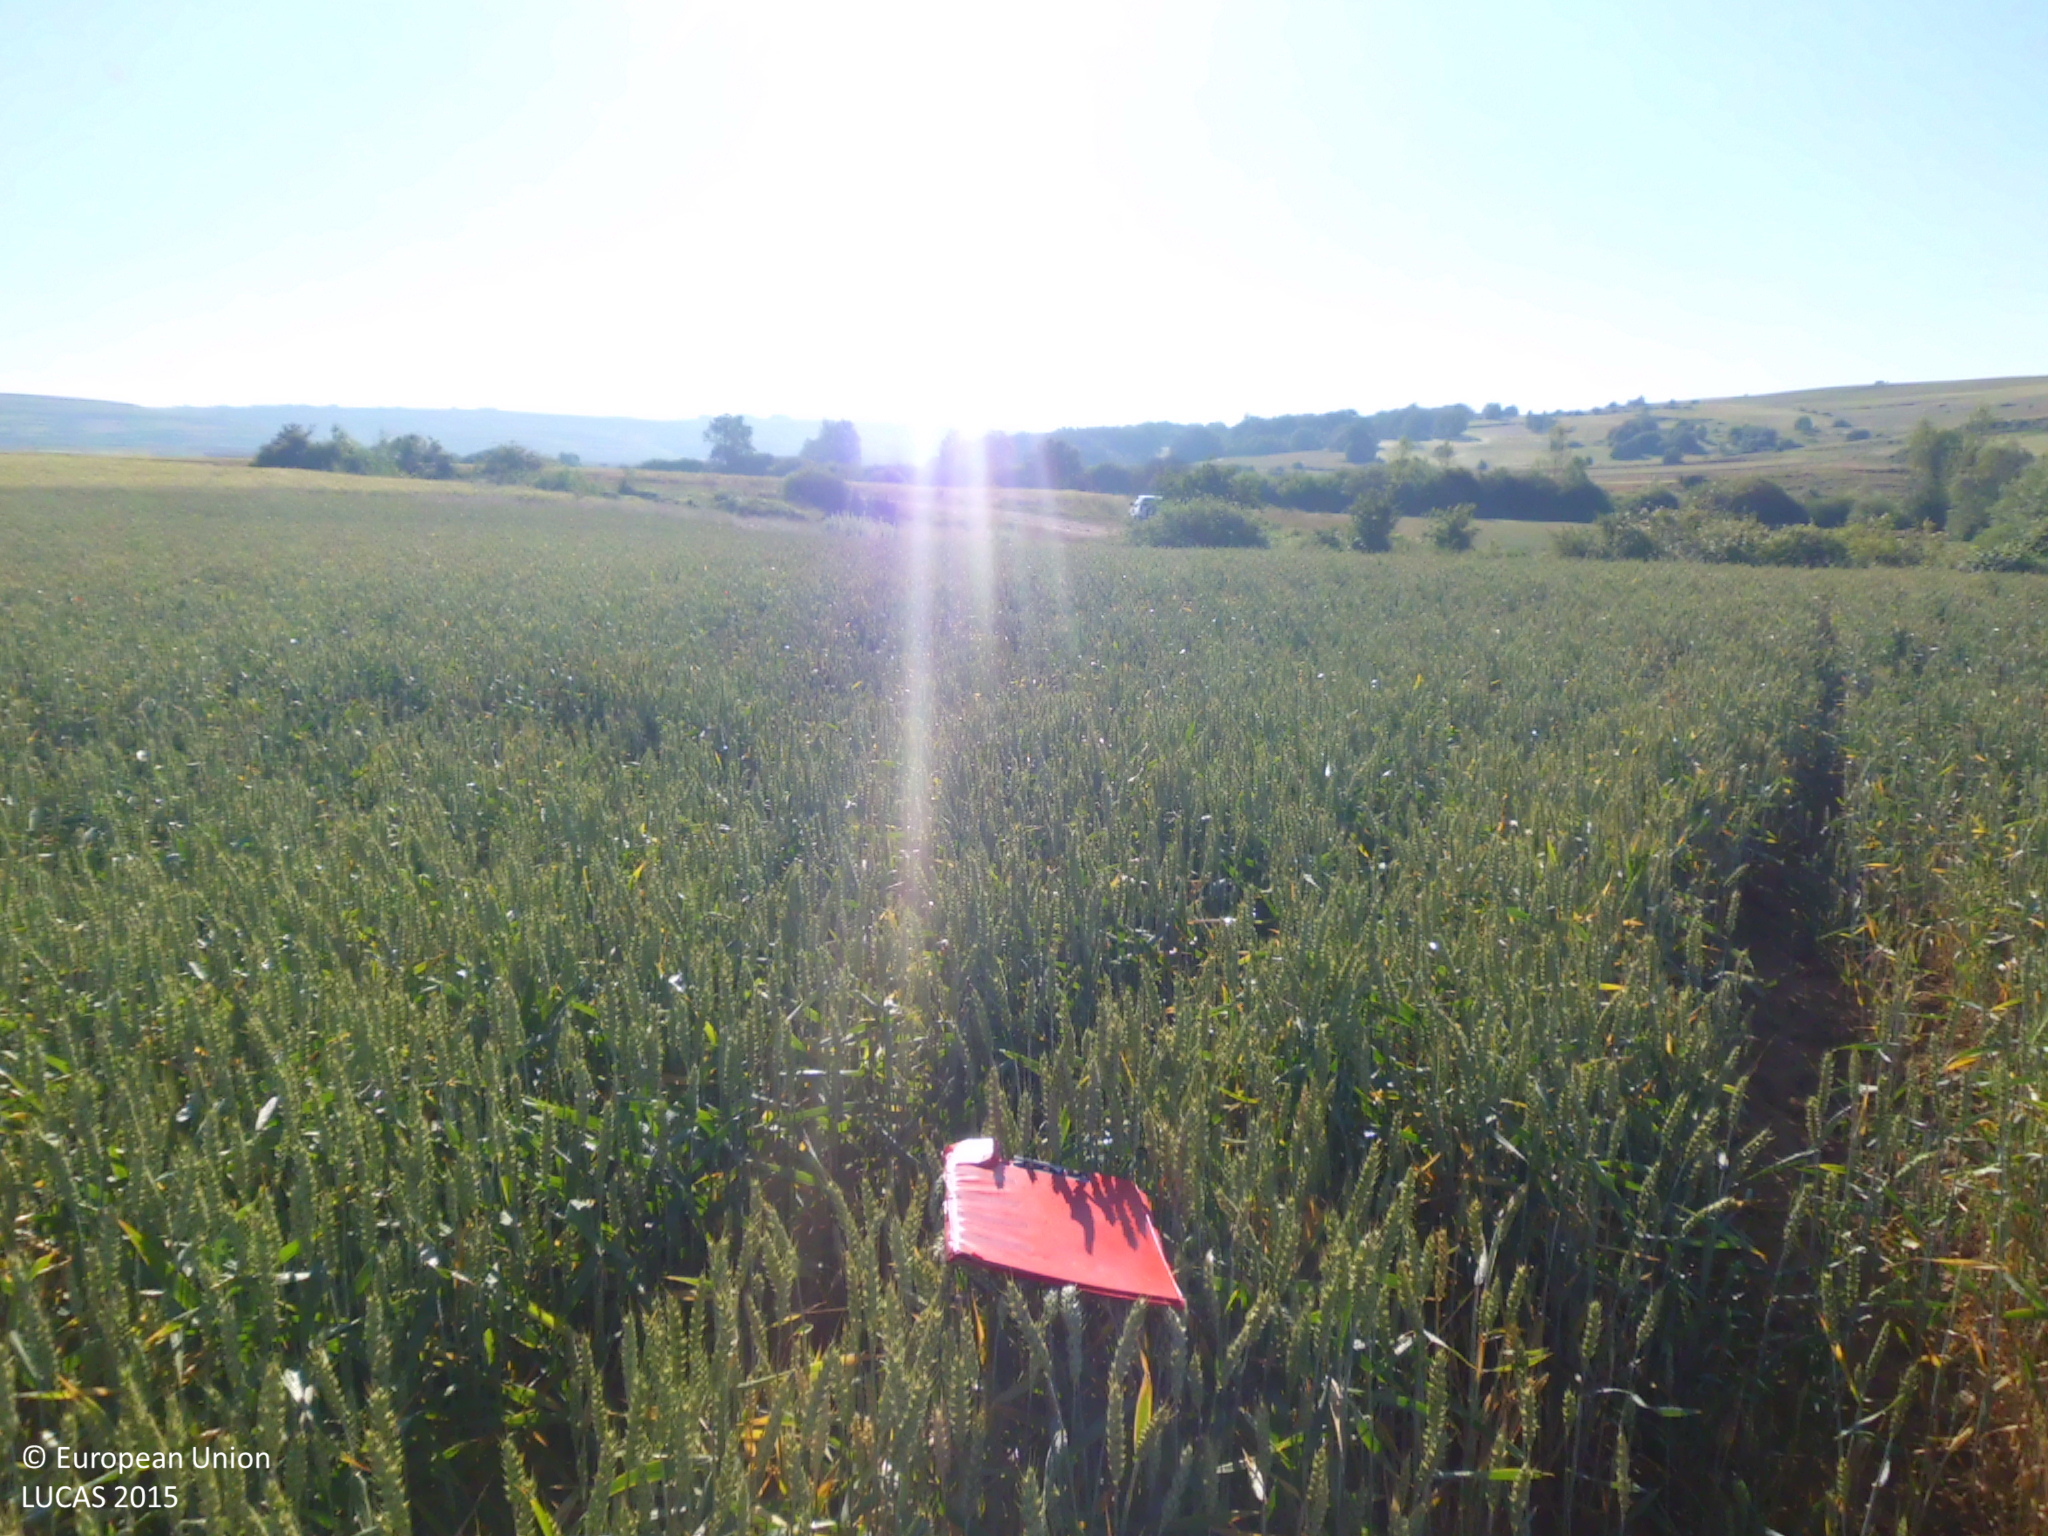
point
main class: Cropland
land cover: Common wheat
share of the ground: > 75 %
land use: Agriculture (excluding fallow land and kitchen gardens)
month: June
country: ES
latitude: 42.6548
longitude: -3.9375
